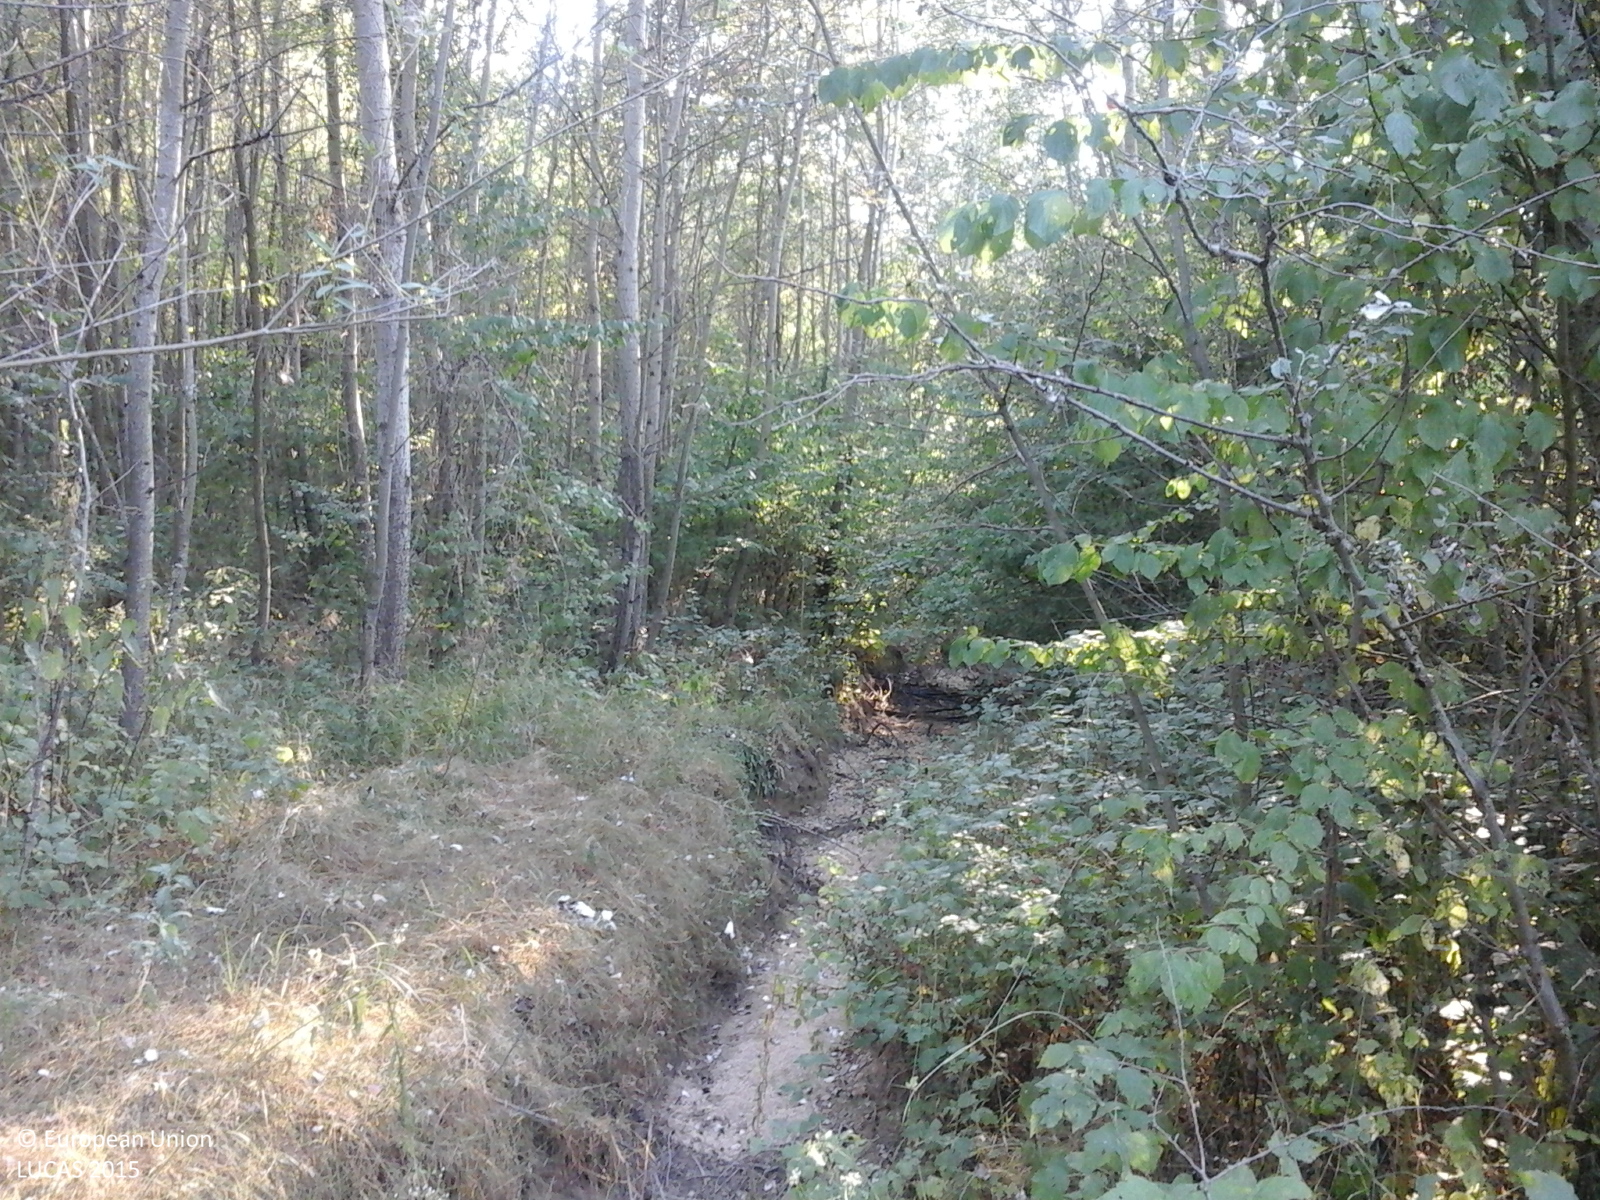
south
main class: Woodland
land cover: Broadleaved woodland
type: acidophilous oak and oak-birch forest
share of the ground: > 75 %
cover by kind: broadleaved forest trees 100 %
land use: Forestry
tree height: > 5 m
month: August
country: RO
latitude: 44.4146
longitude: 23.6307
